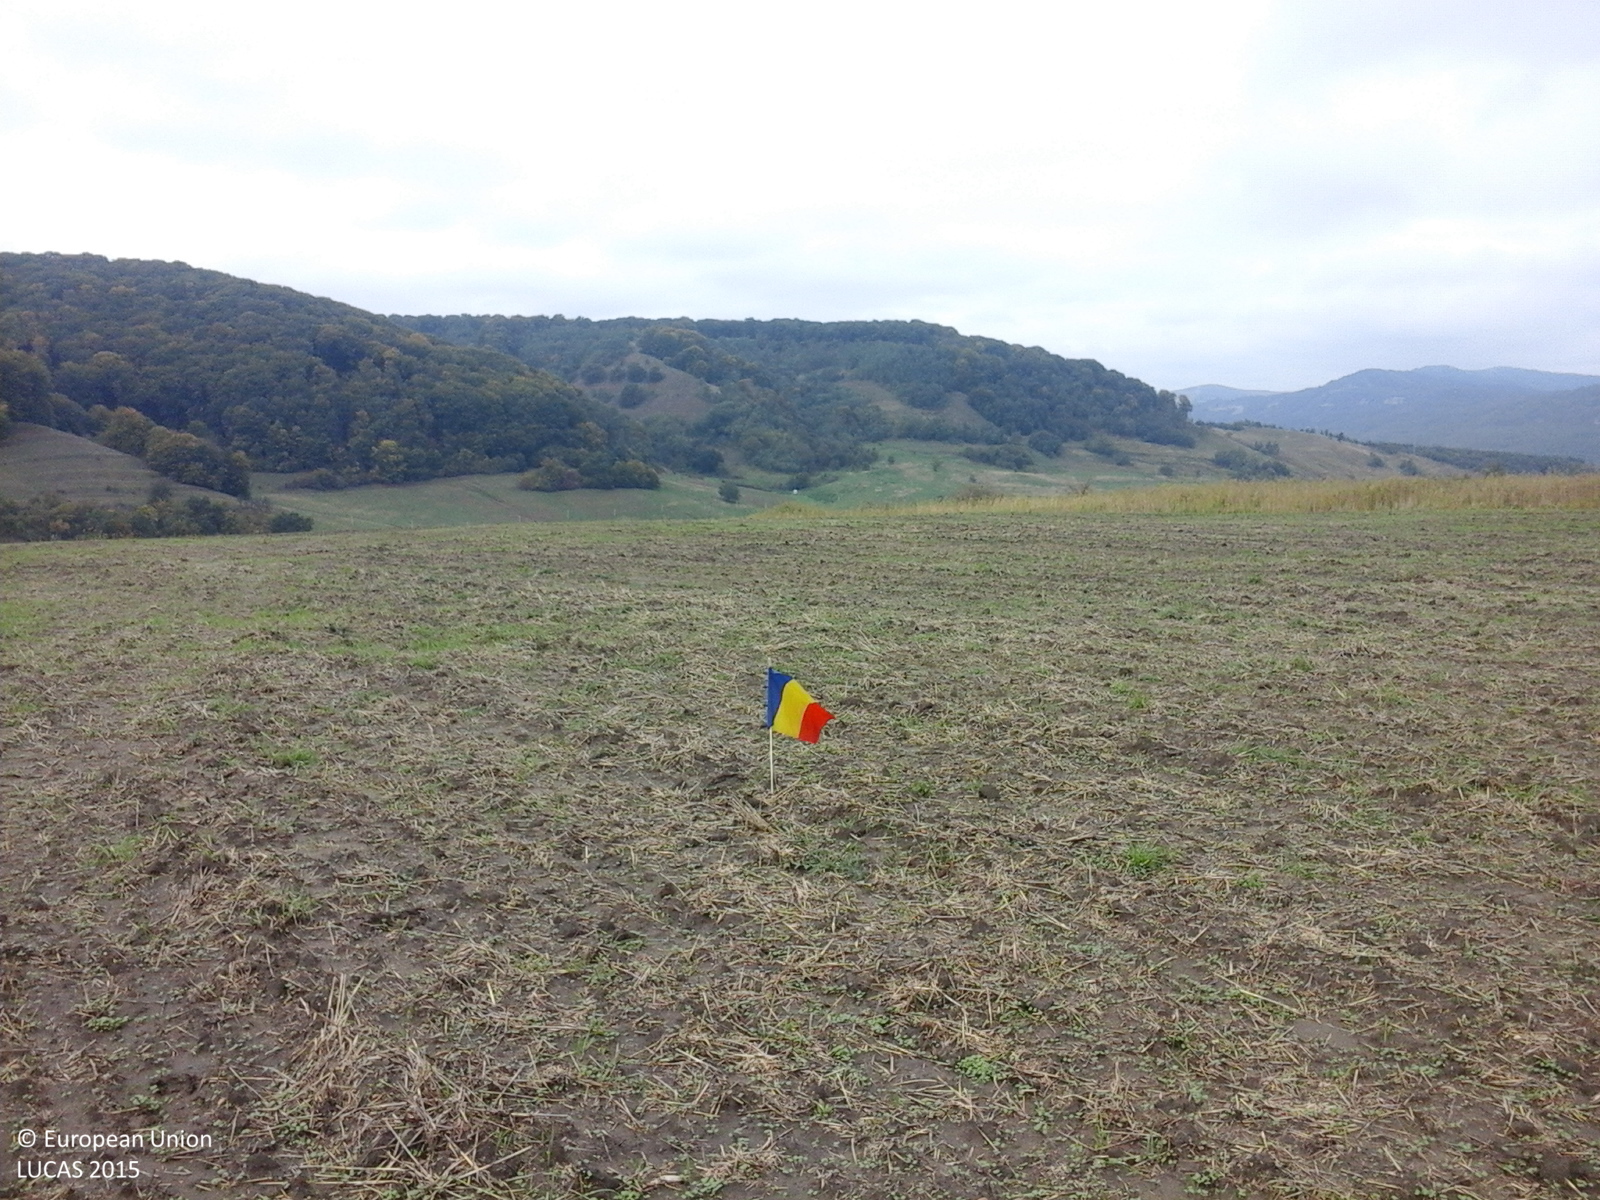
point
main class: Cropland
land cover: Rape and turnip rape
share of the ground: < 10 %
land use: Agriculture (excluding fallow land and kitchen gardens)
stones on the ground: < 10 %
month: October
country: RO
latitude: 46.1013
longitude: 24.2702
